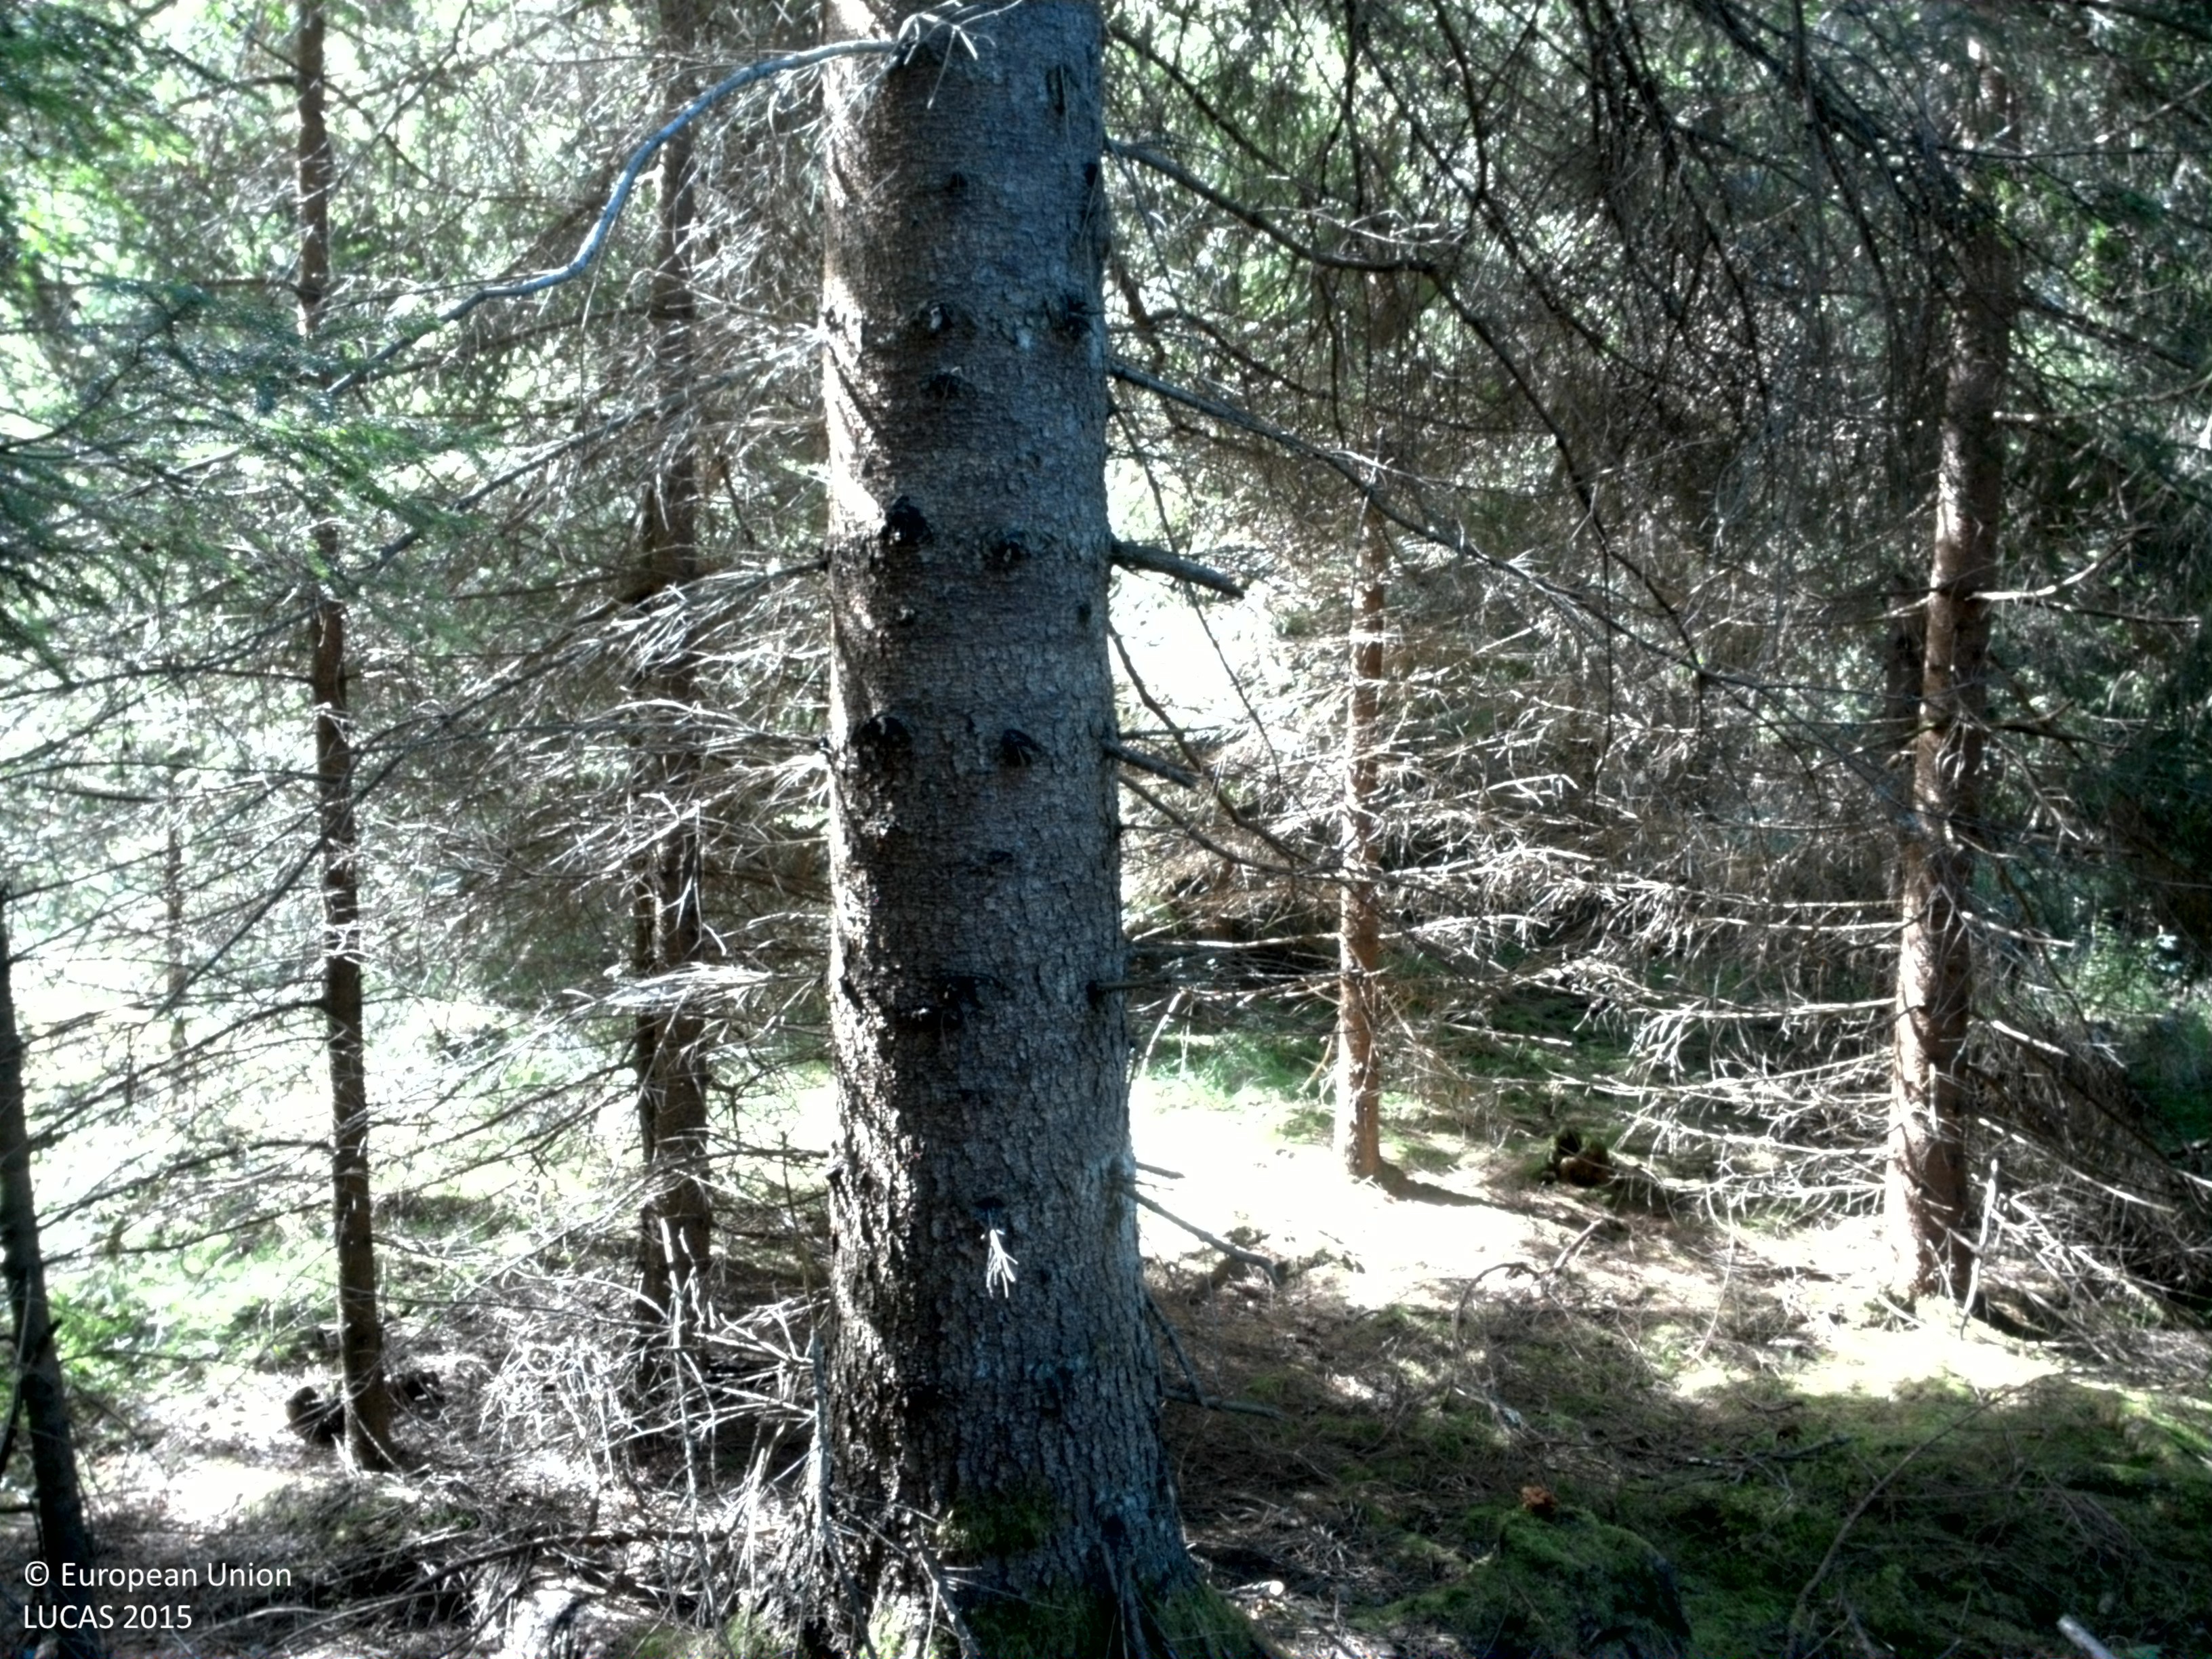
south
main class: Woodland
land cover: Spruce dominated coniferous woodland
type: boreal forest
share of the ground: 50 - 75 %
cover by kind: coniferous forest trees 70 %, lichens and mosses 25 %, herbaceous plants 5 %
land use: Forestry
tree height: > 5 m
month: August
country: SE
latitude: 58.2147
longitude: 13.3137
